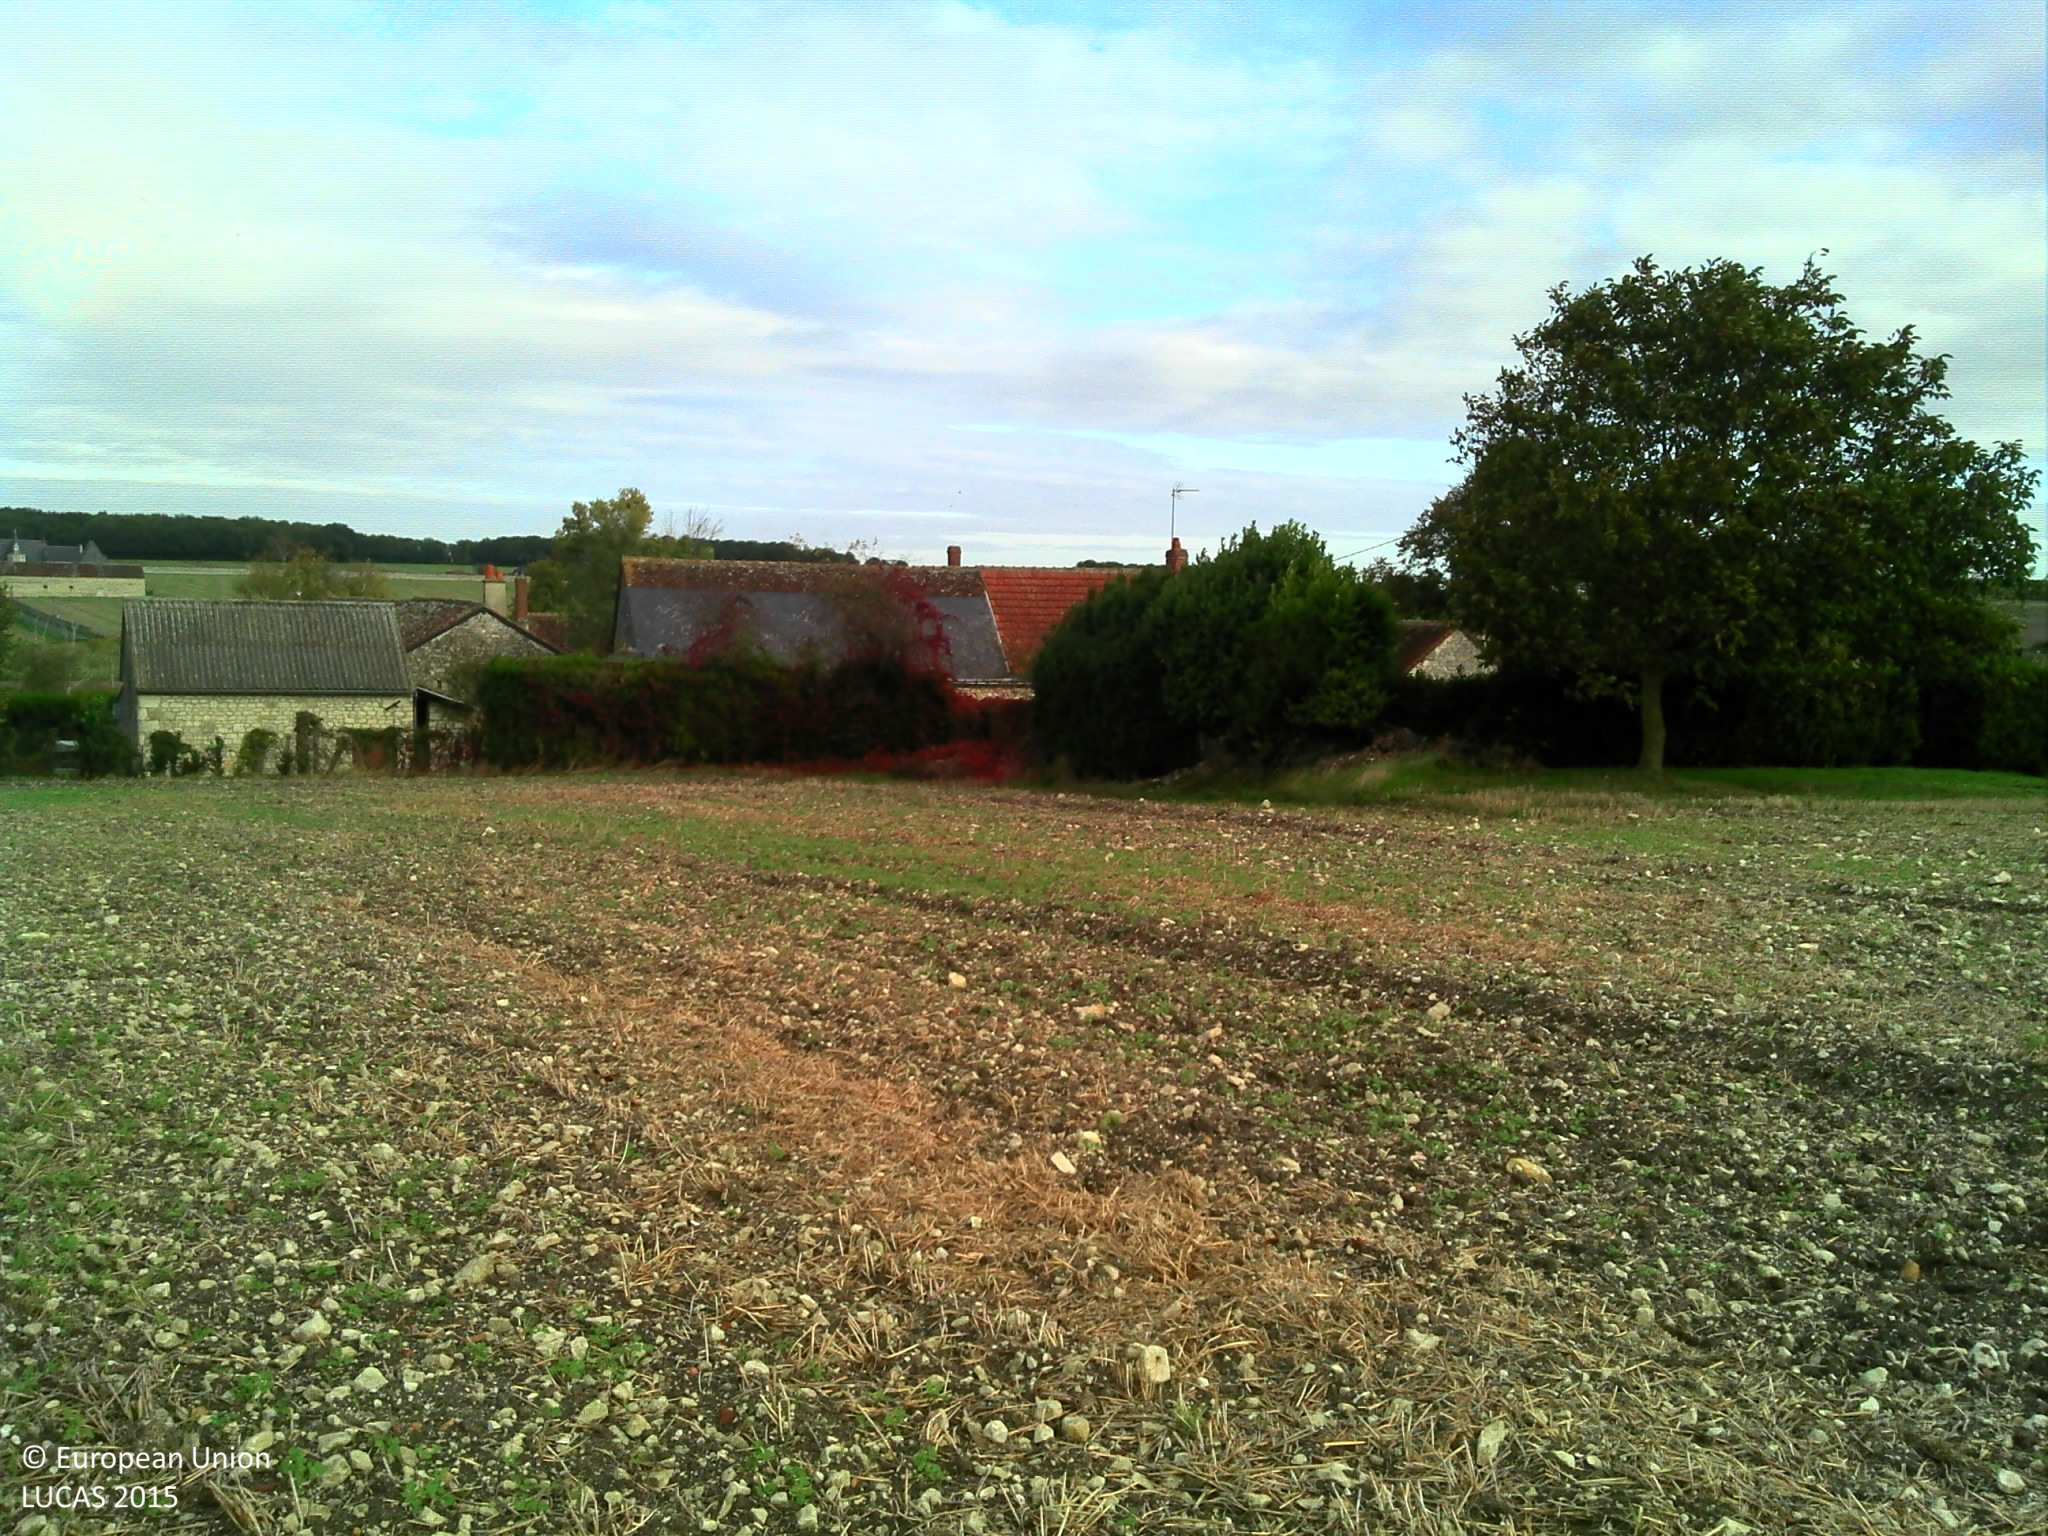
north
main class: Cropland
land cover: Barley
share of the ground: > 75 %
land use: Agriculture (excluding fallow land and kitchen gardens)
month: October
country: FR
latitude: 47.0752
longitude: 0.5645
